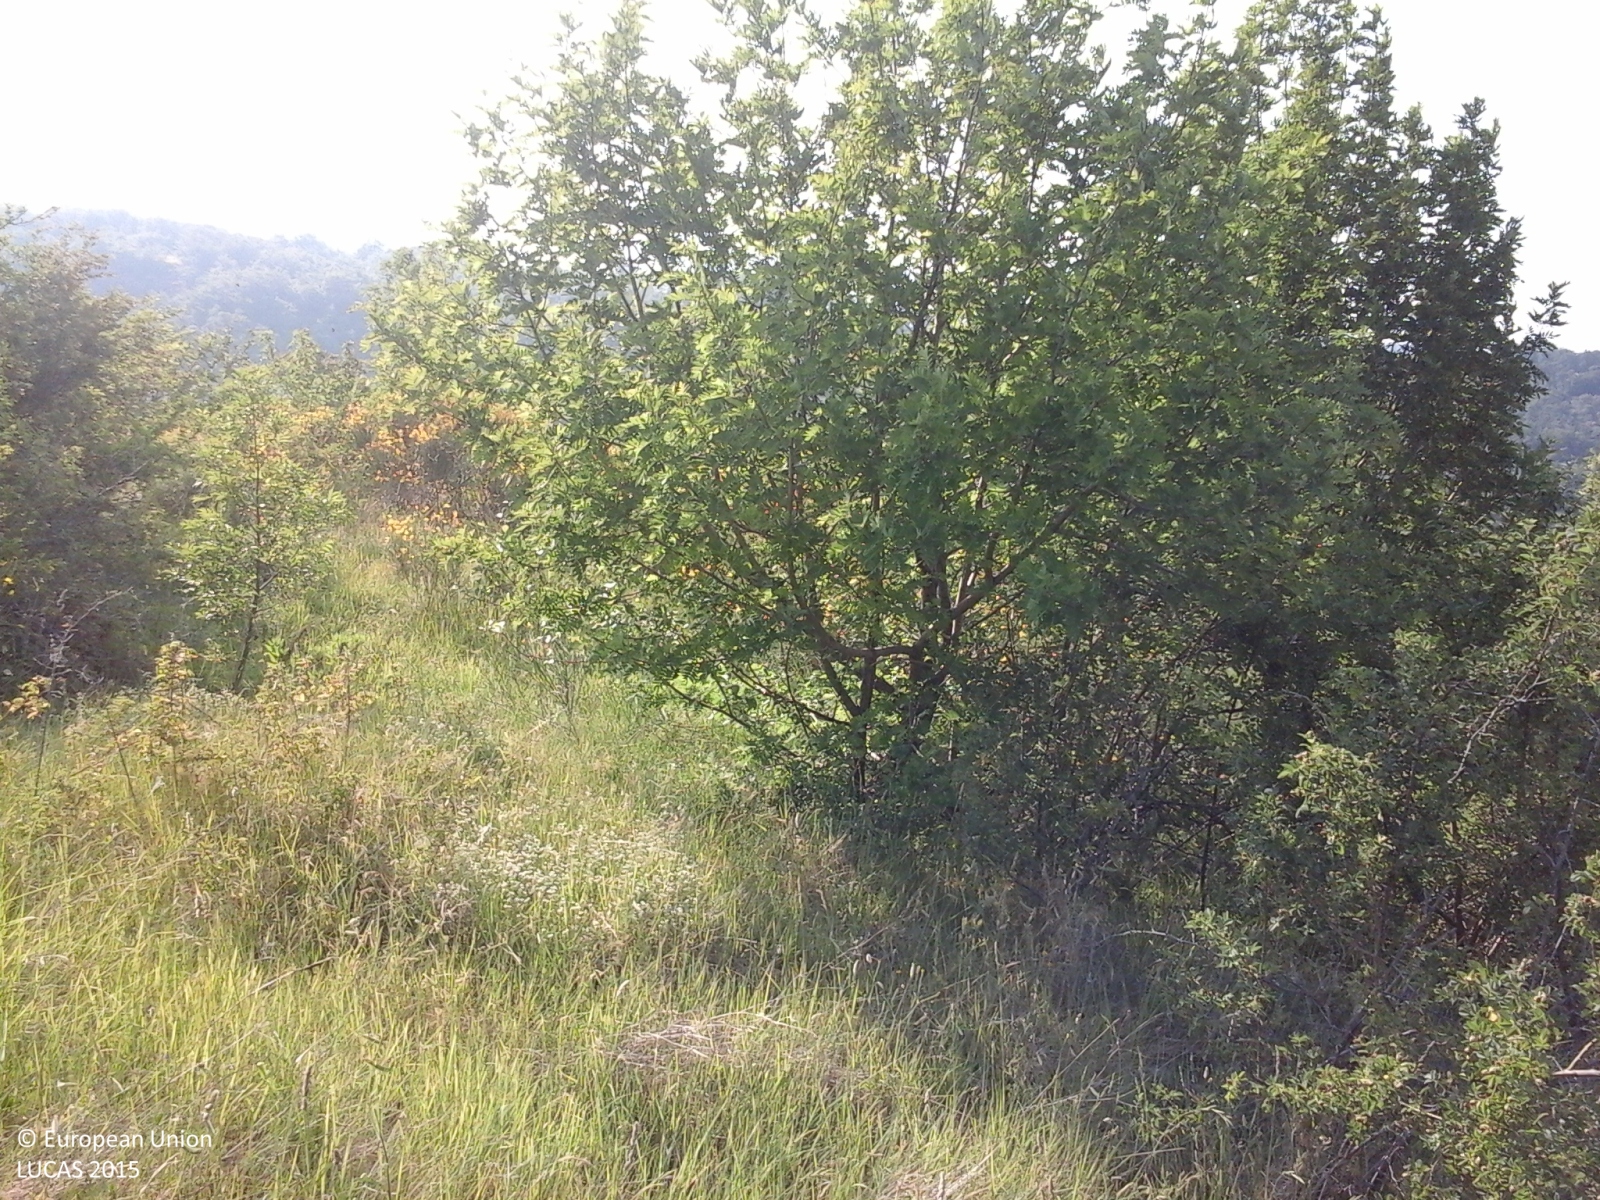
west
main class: Woodland
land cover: Broadleaved woodland
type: thermophilous deciduous forest
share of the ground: > 75 %
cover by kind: broadleaved forest trees 60 %, shrubs 30 %, herbaceous plants 10 %
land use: Semi-natural and natural areas not in use
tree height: < 5 m
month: June
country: IT
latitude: 42.0382
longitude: 14.2987
